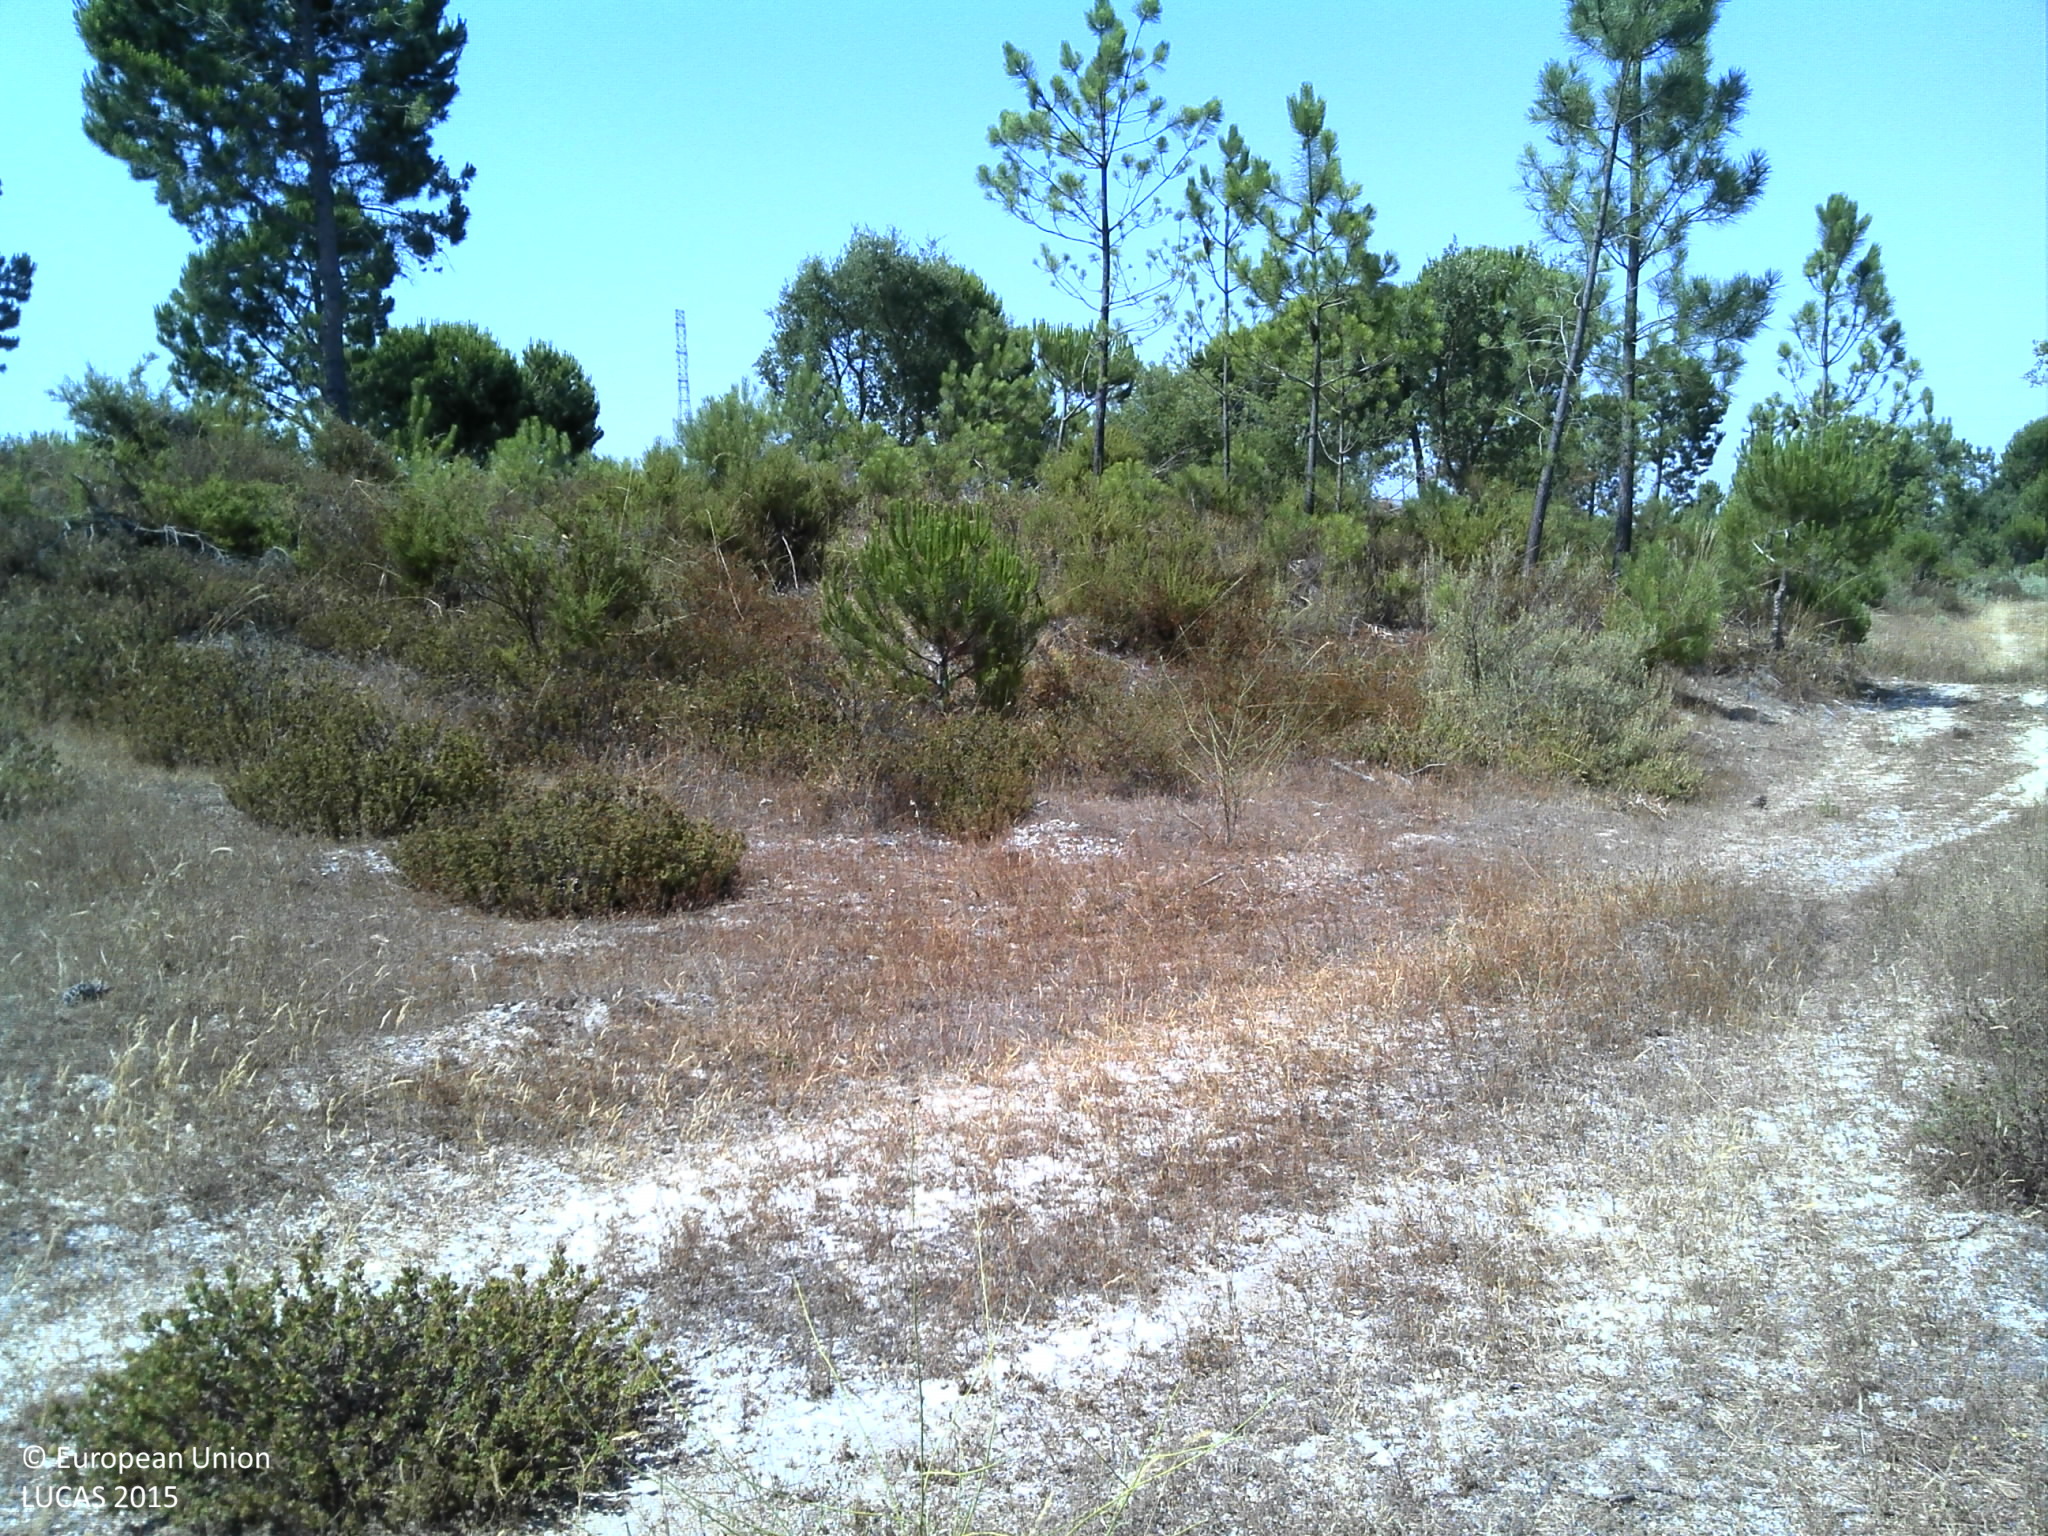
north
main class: Grassland
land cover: Grassland with sparse tree/shrub cover
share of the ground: 25 - 50 %
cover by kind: unconsolidated bare surface 60 %, herbaceous plants 35 %, coniferous forest trees 5 %
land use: Forestry
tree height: > 5 m
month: June
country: PT
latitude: 38.5812
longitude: -9.0685
